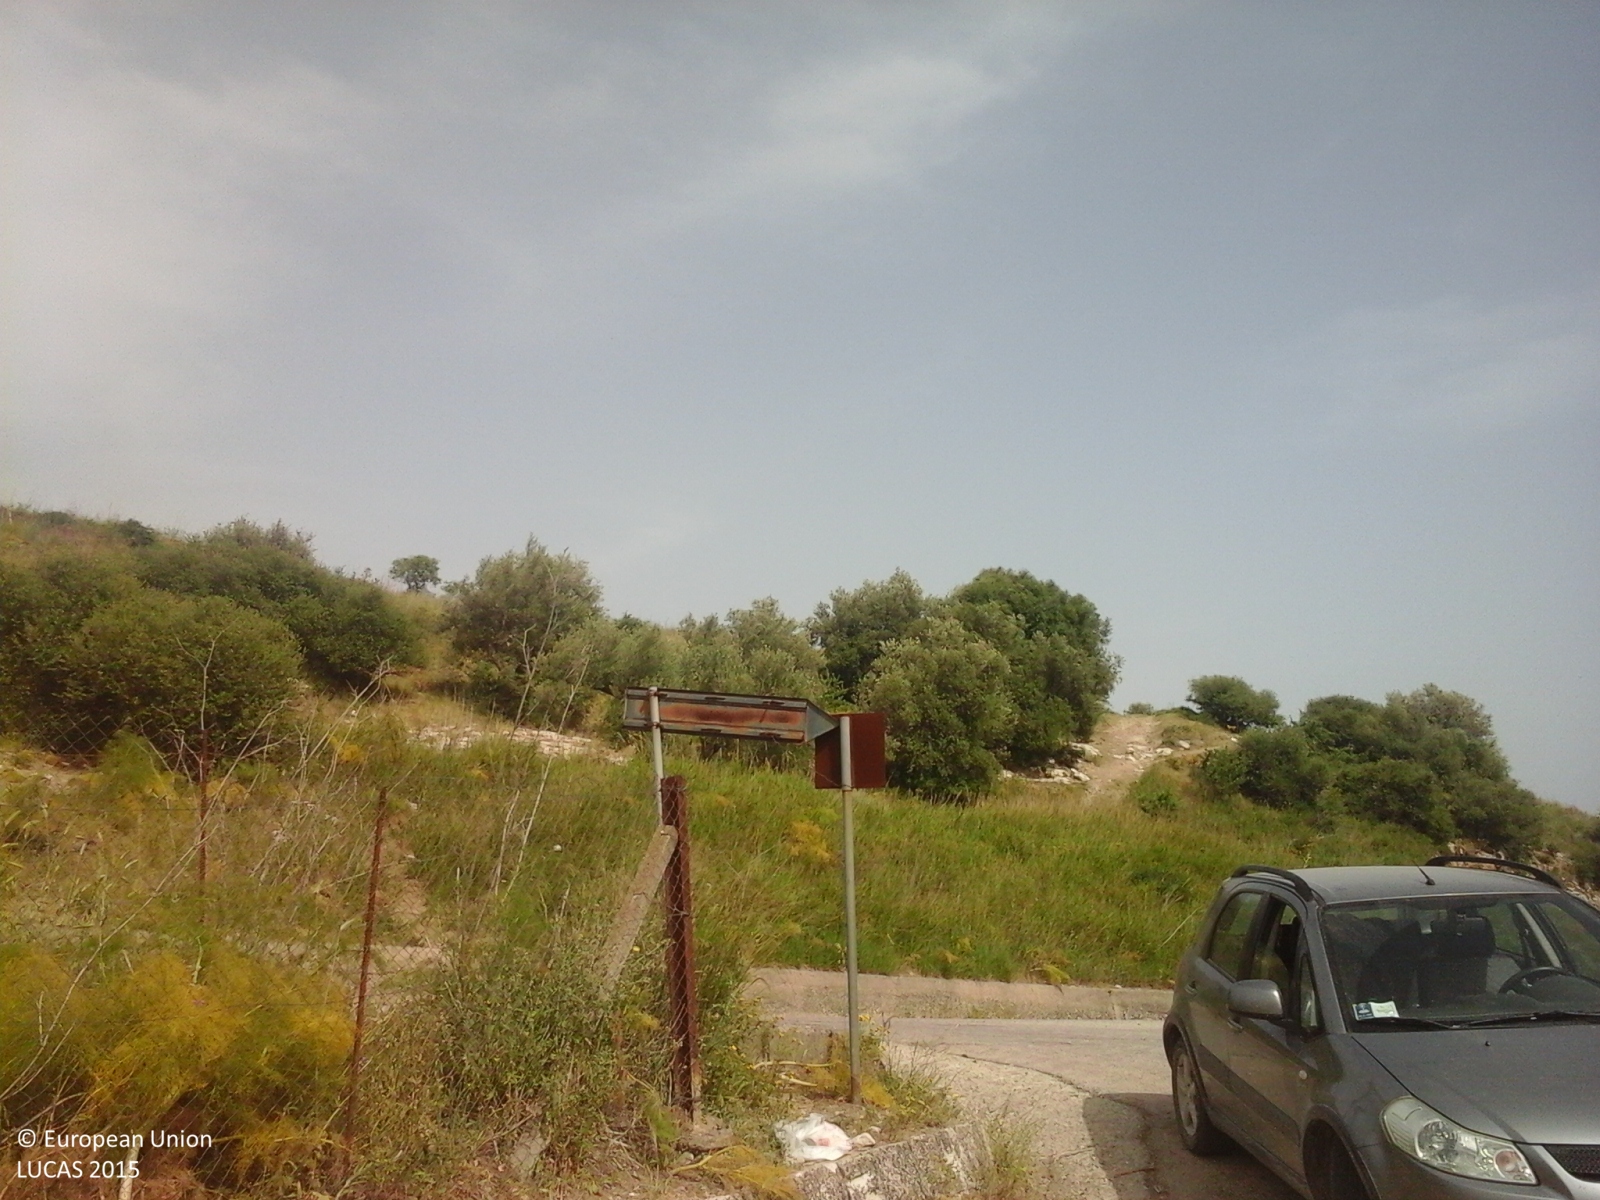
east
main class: Cropland
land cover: Olive groves
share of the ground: > 75 %
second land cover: Grassland without tree/shrub cover
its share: > 75 %
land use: Agriculture (excluding fallow land and kitchen gardens)
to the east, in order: Olive groves; Grassland without tree/shrub cover
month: May
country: IT
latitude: 37.5757
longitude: 13.9226
